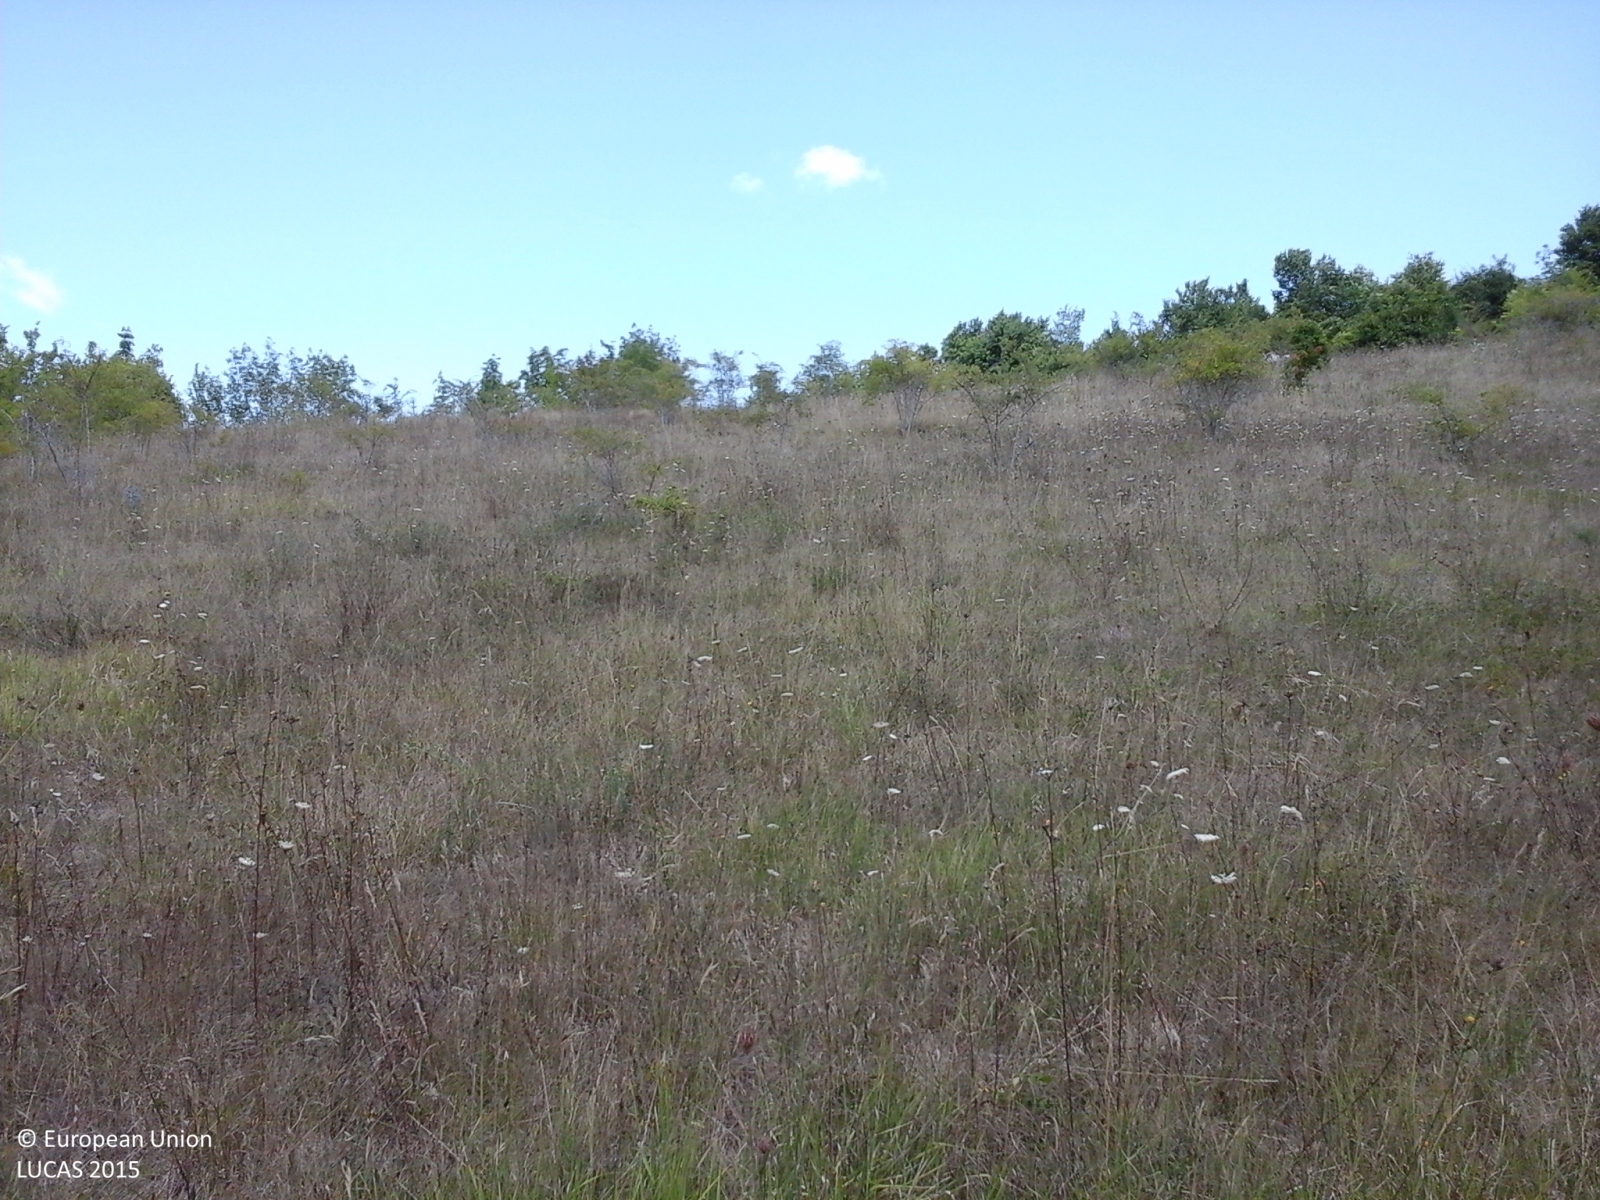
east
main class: Woodland
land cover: Broadleaved woodland
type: thermophilous deciduous forest
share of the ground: > 75 %
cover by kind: broadleaved forest trees 75 %, shrubs 20 %, herbaceous plants 5 %
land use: Semi-natural and natural areas not in use
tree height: > 5 m
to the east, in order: Broadleaved woodland
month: August
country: IT
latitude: 41.5831
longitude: 14.3626
